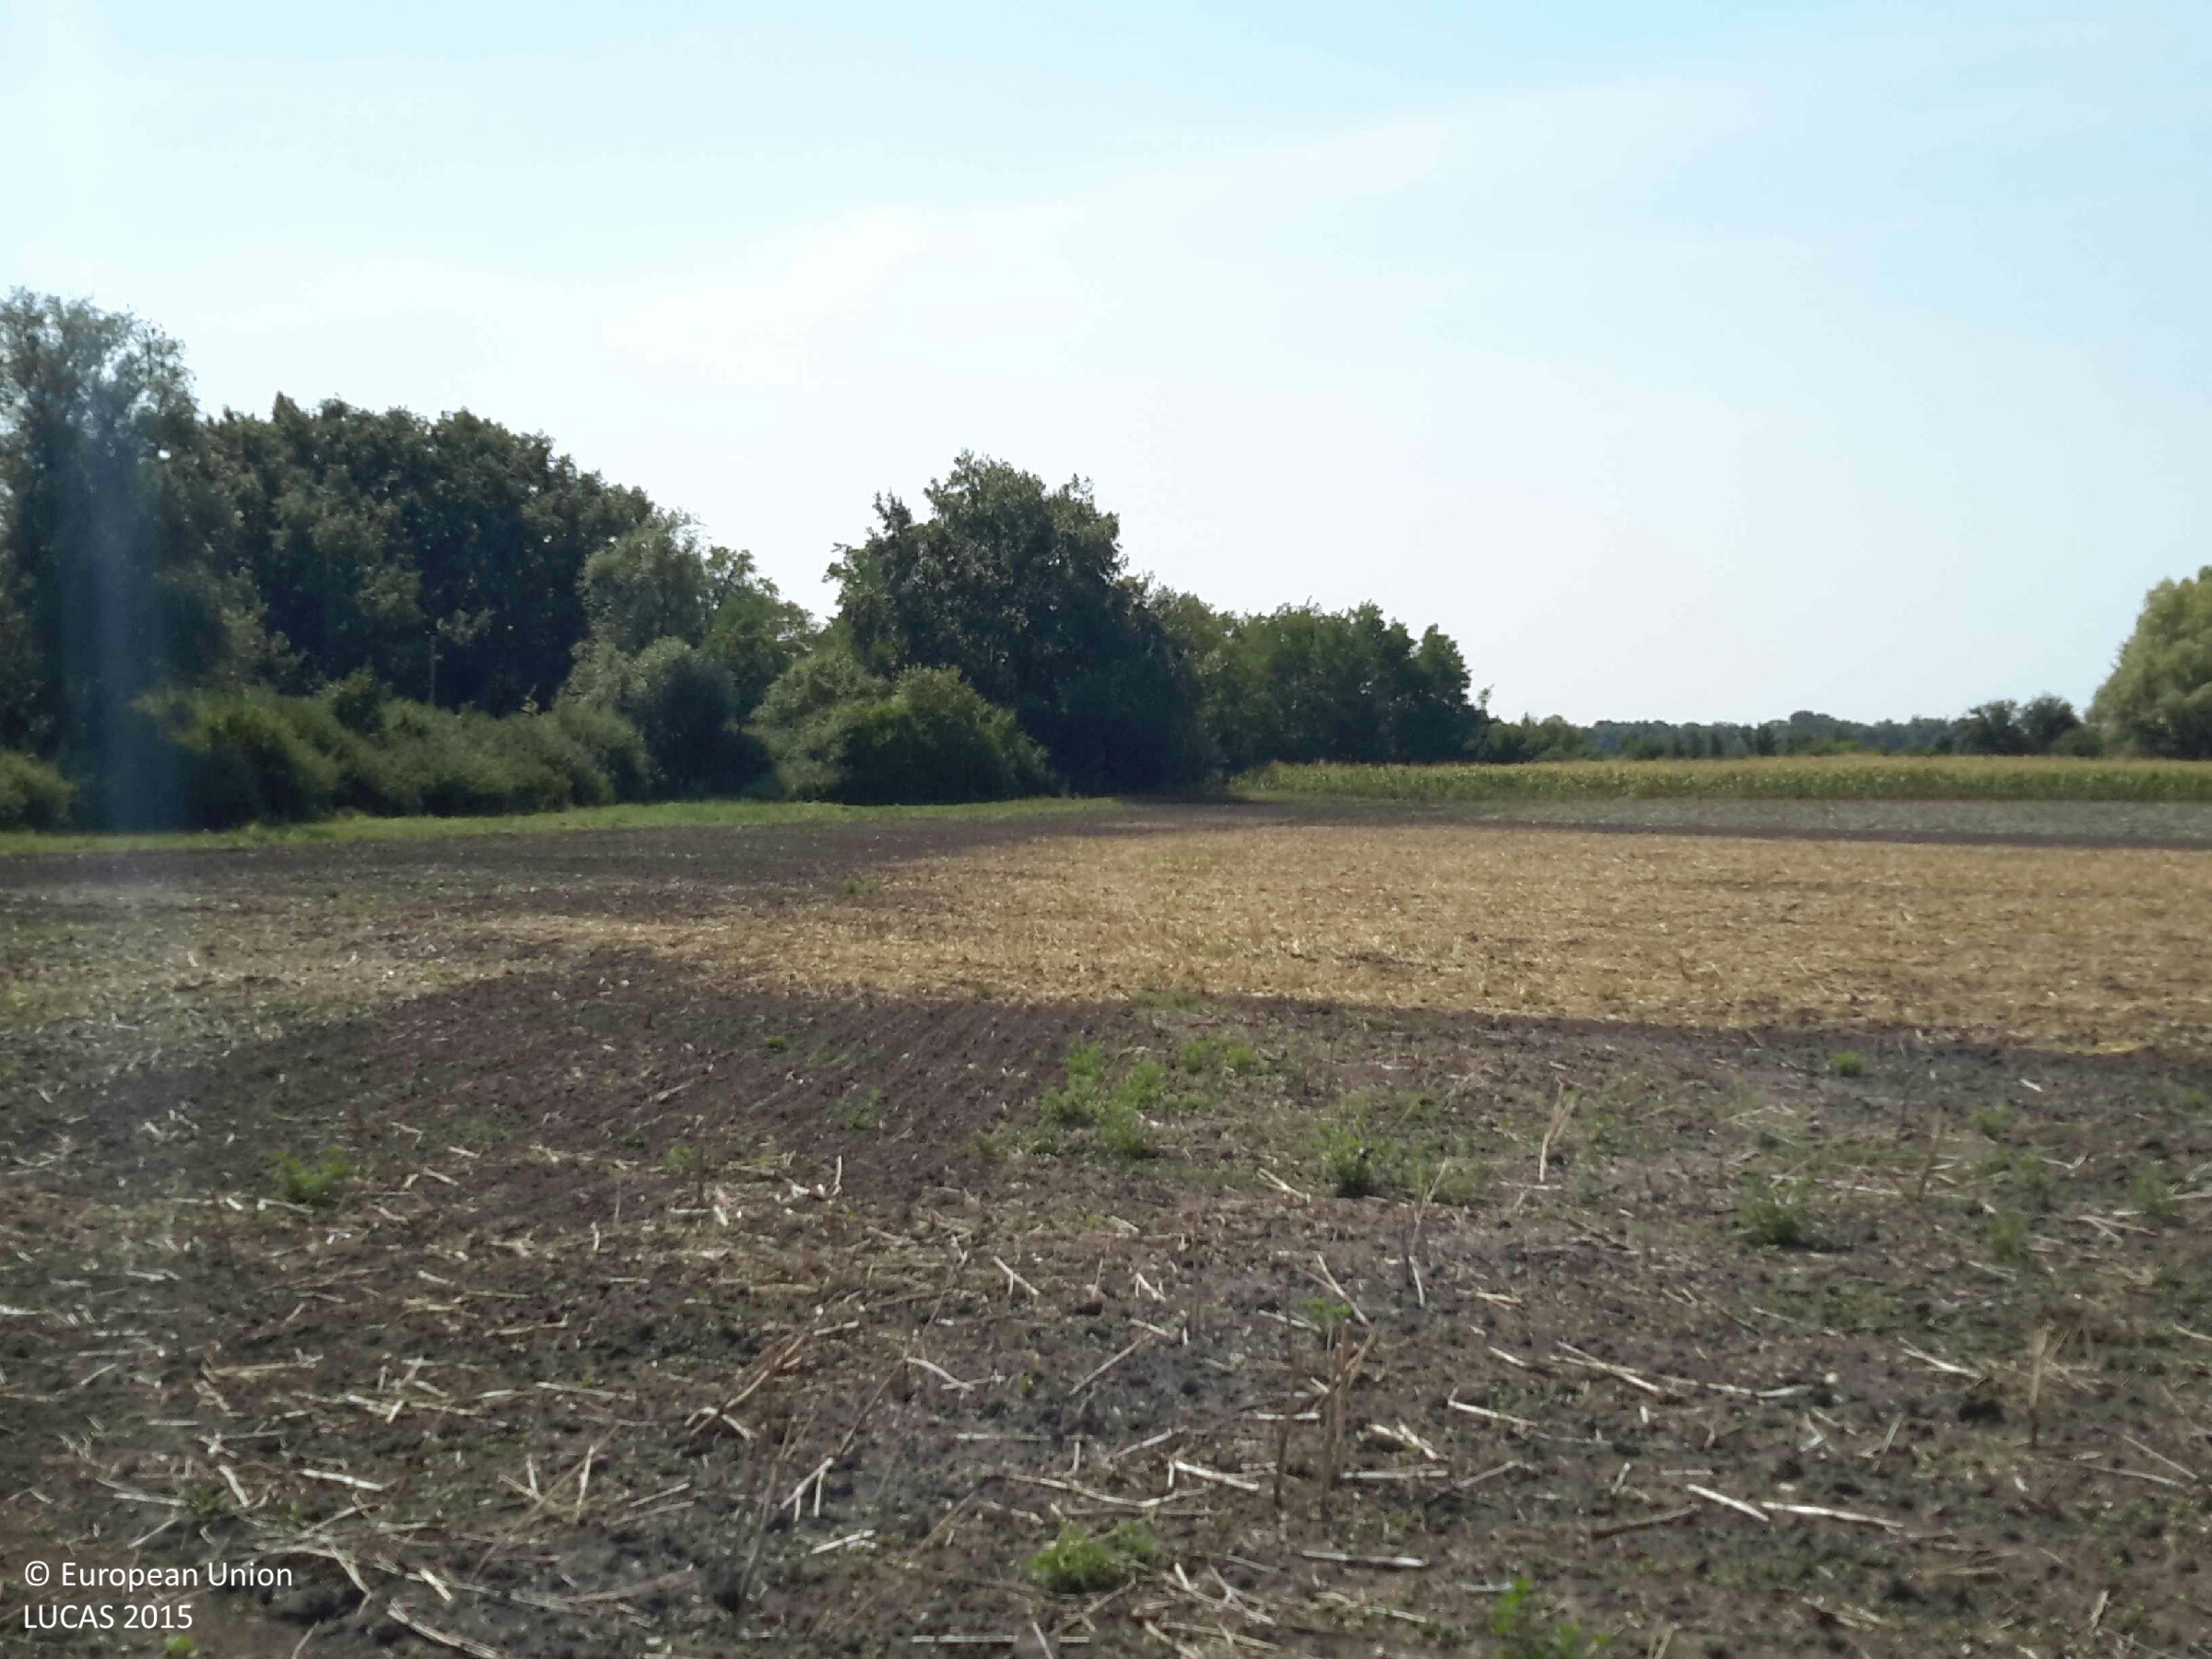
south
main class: Cropland
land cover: Rape and turnip rape
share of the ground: < 10 %
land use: Agriculture (excluding fallow land and kitchen gardens)
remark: Harvested field
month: August
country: HU
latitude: 47.7585
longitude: 17.1175
